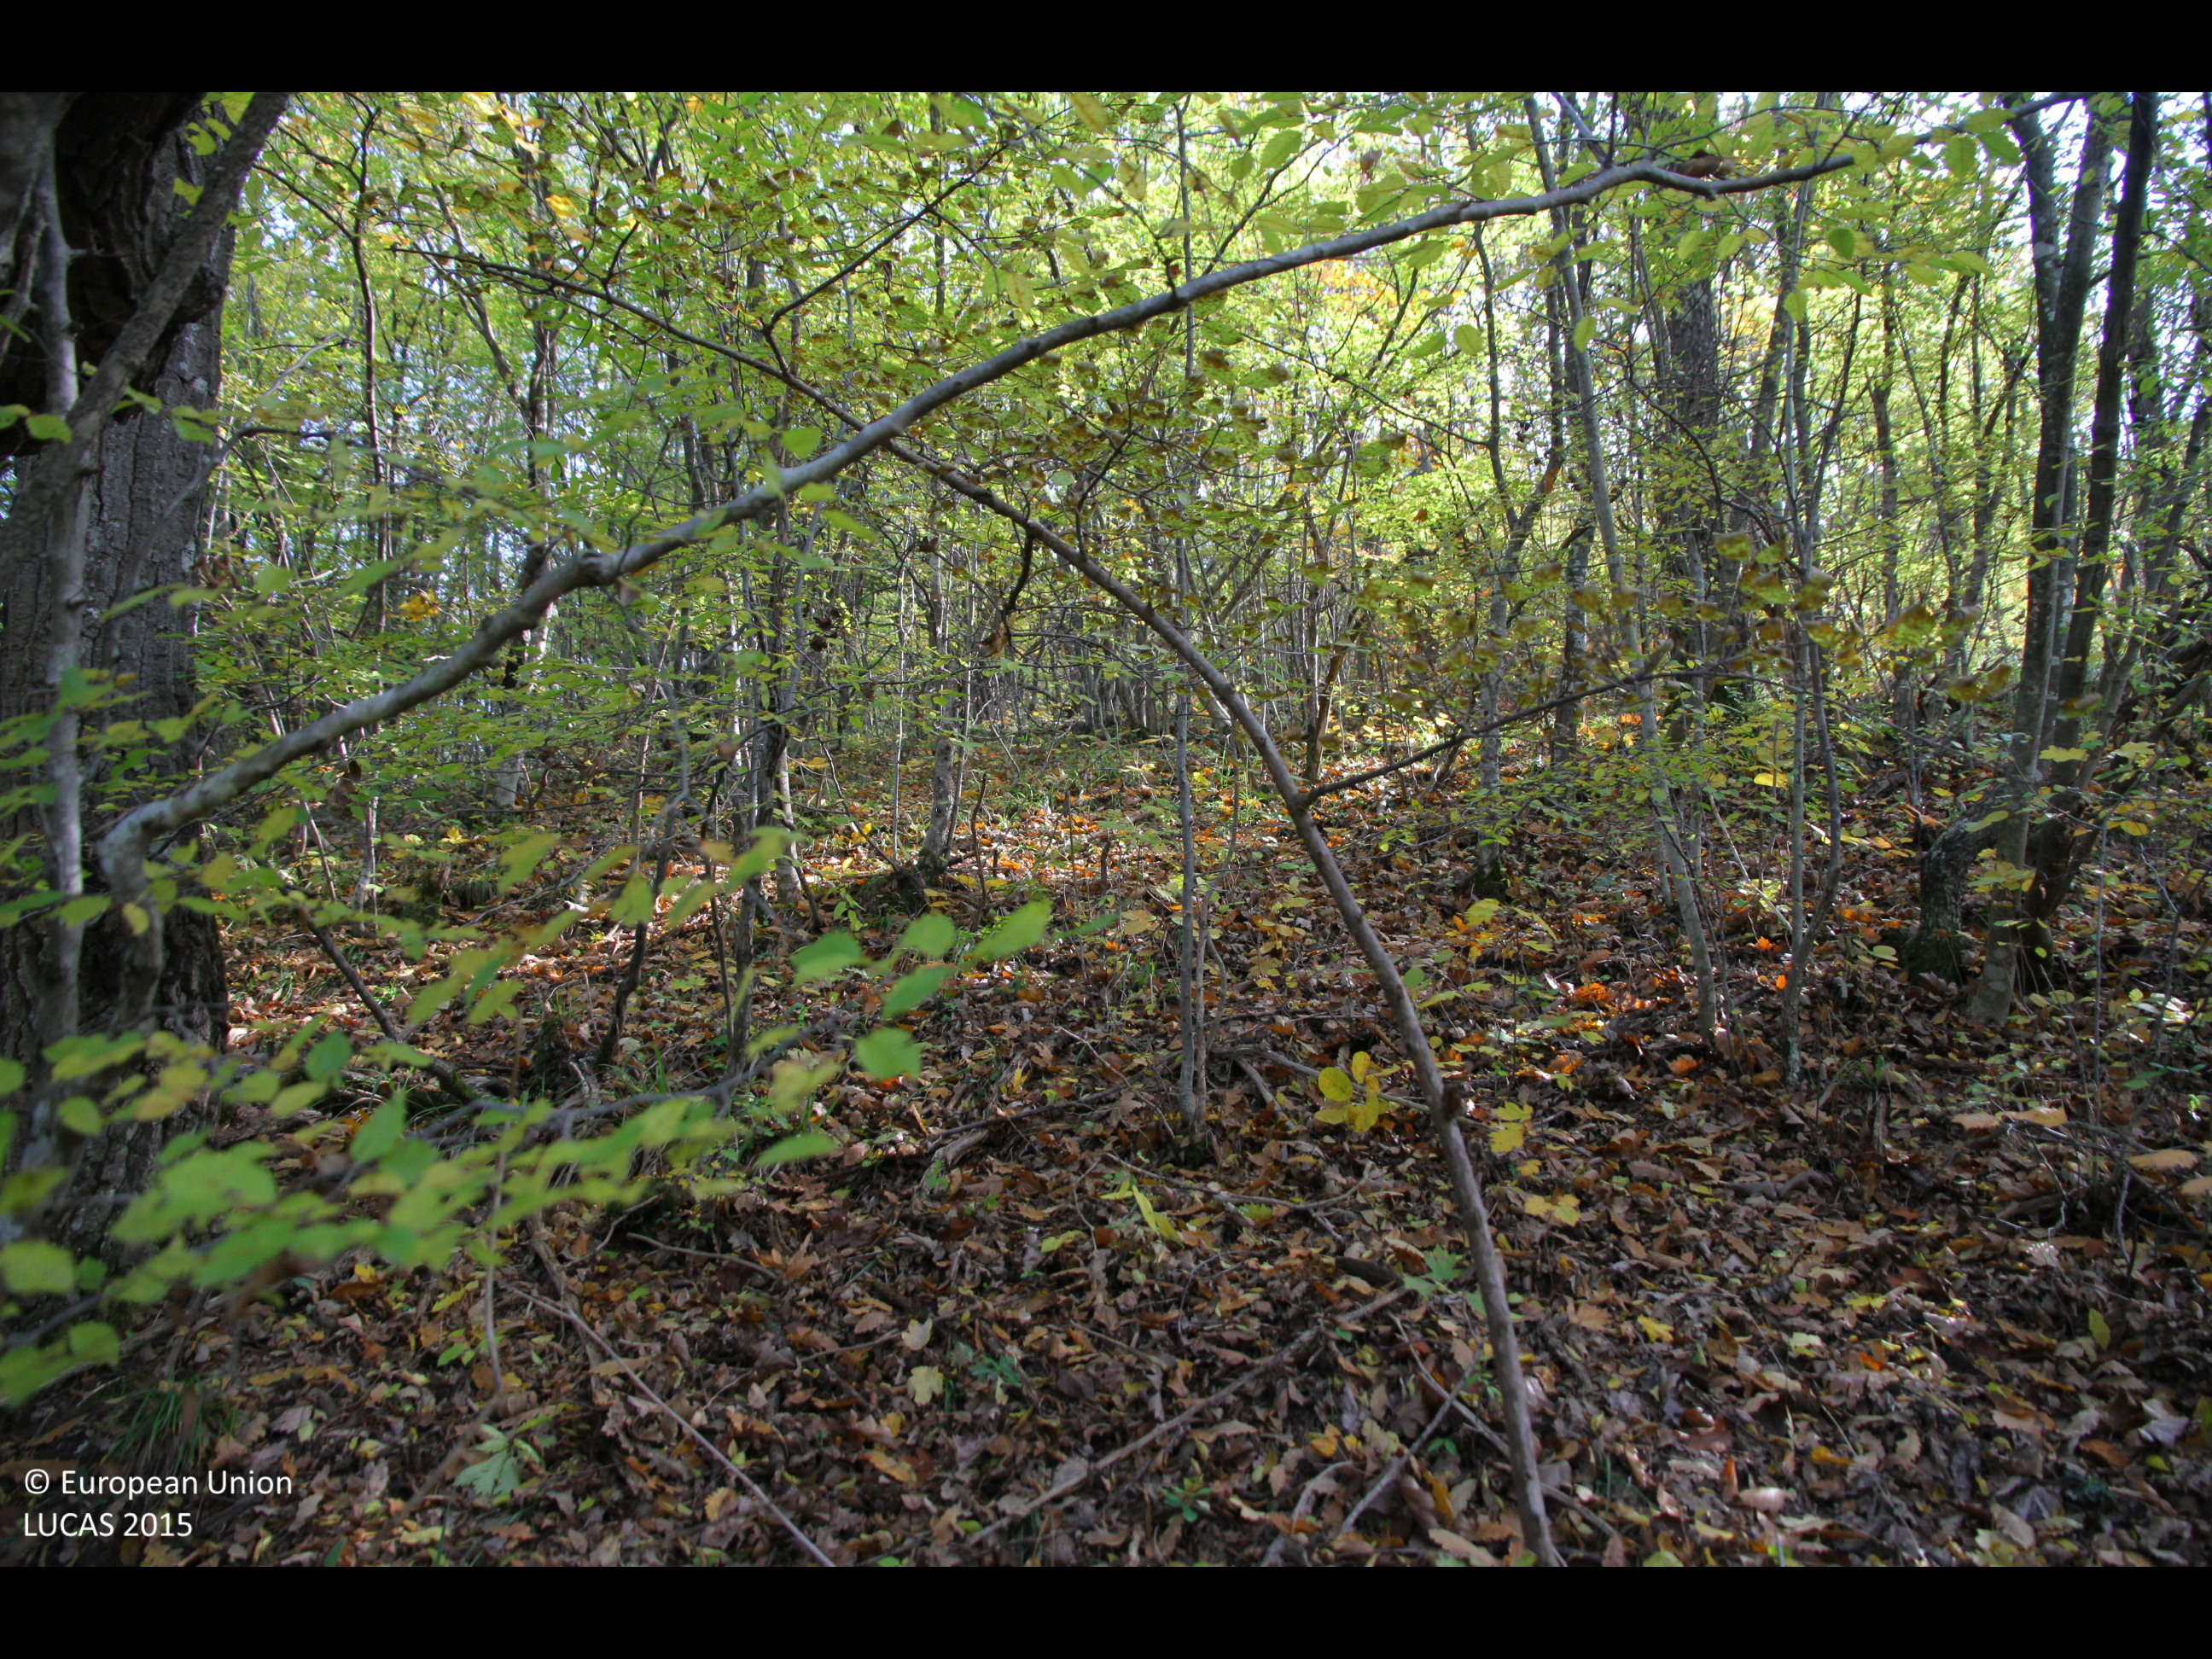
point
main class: Woodland
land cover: Broadleaved woodland
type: mesophytic deciduous forest
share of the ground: > 75 %
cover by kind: broadleaved forest trees 100 %
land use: Forestry
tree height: > 5 m
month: October
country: BG
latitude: 43.1320
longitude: 26.8144
